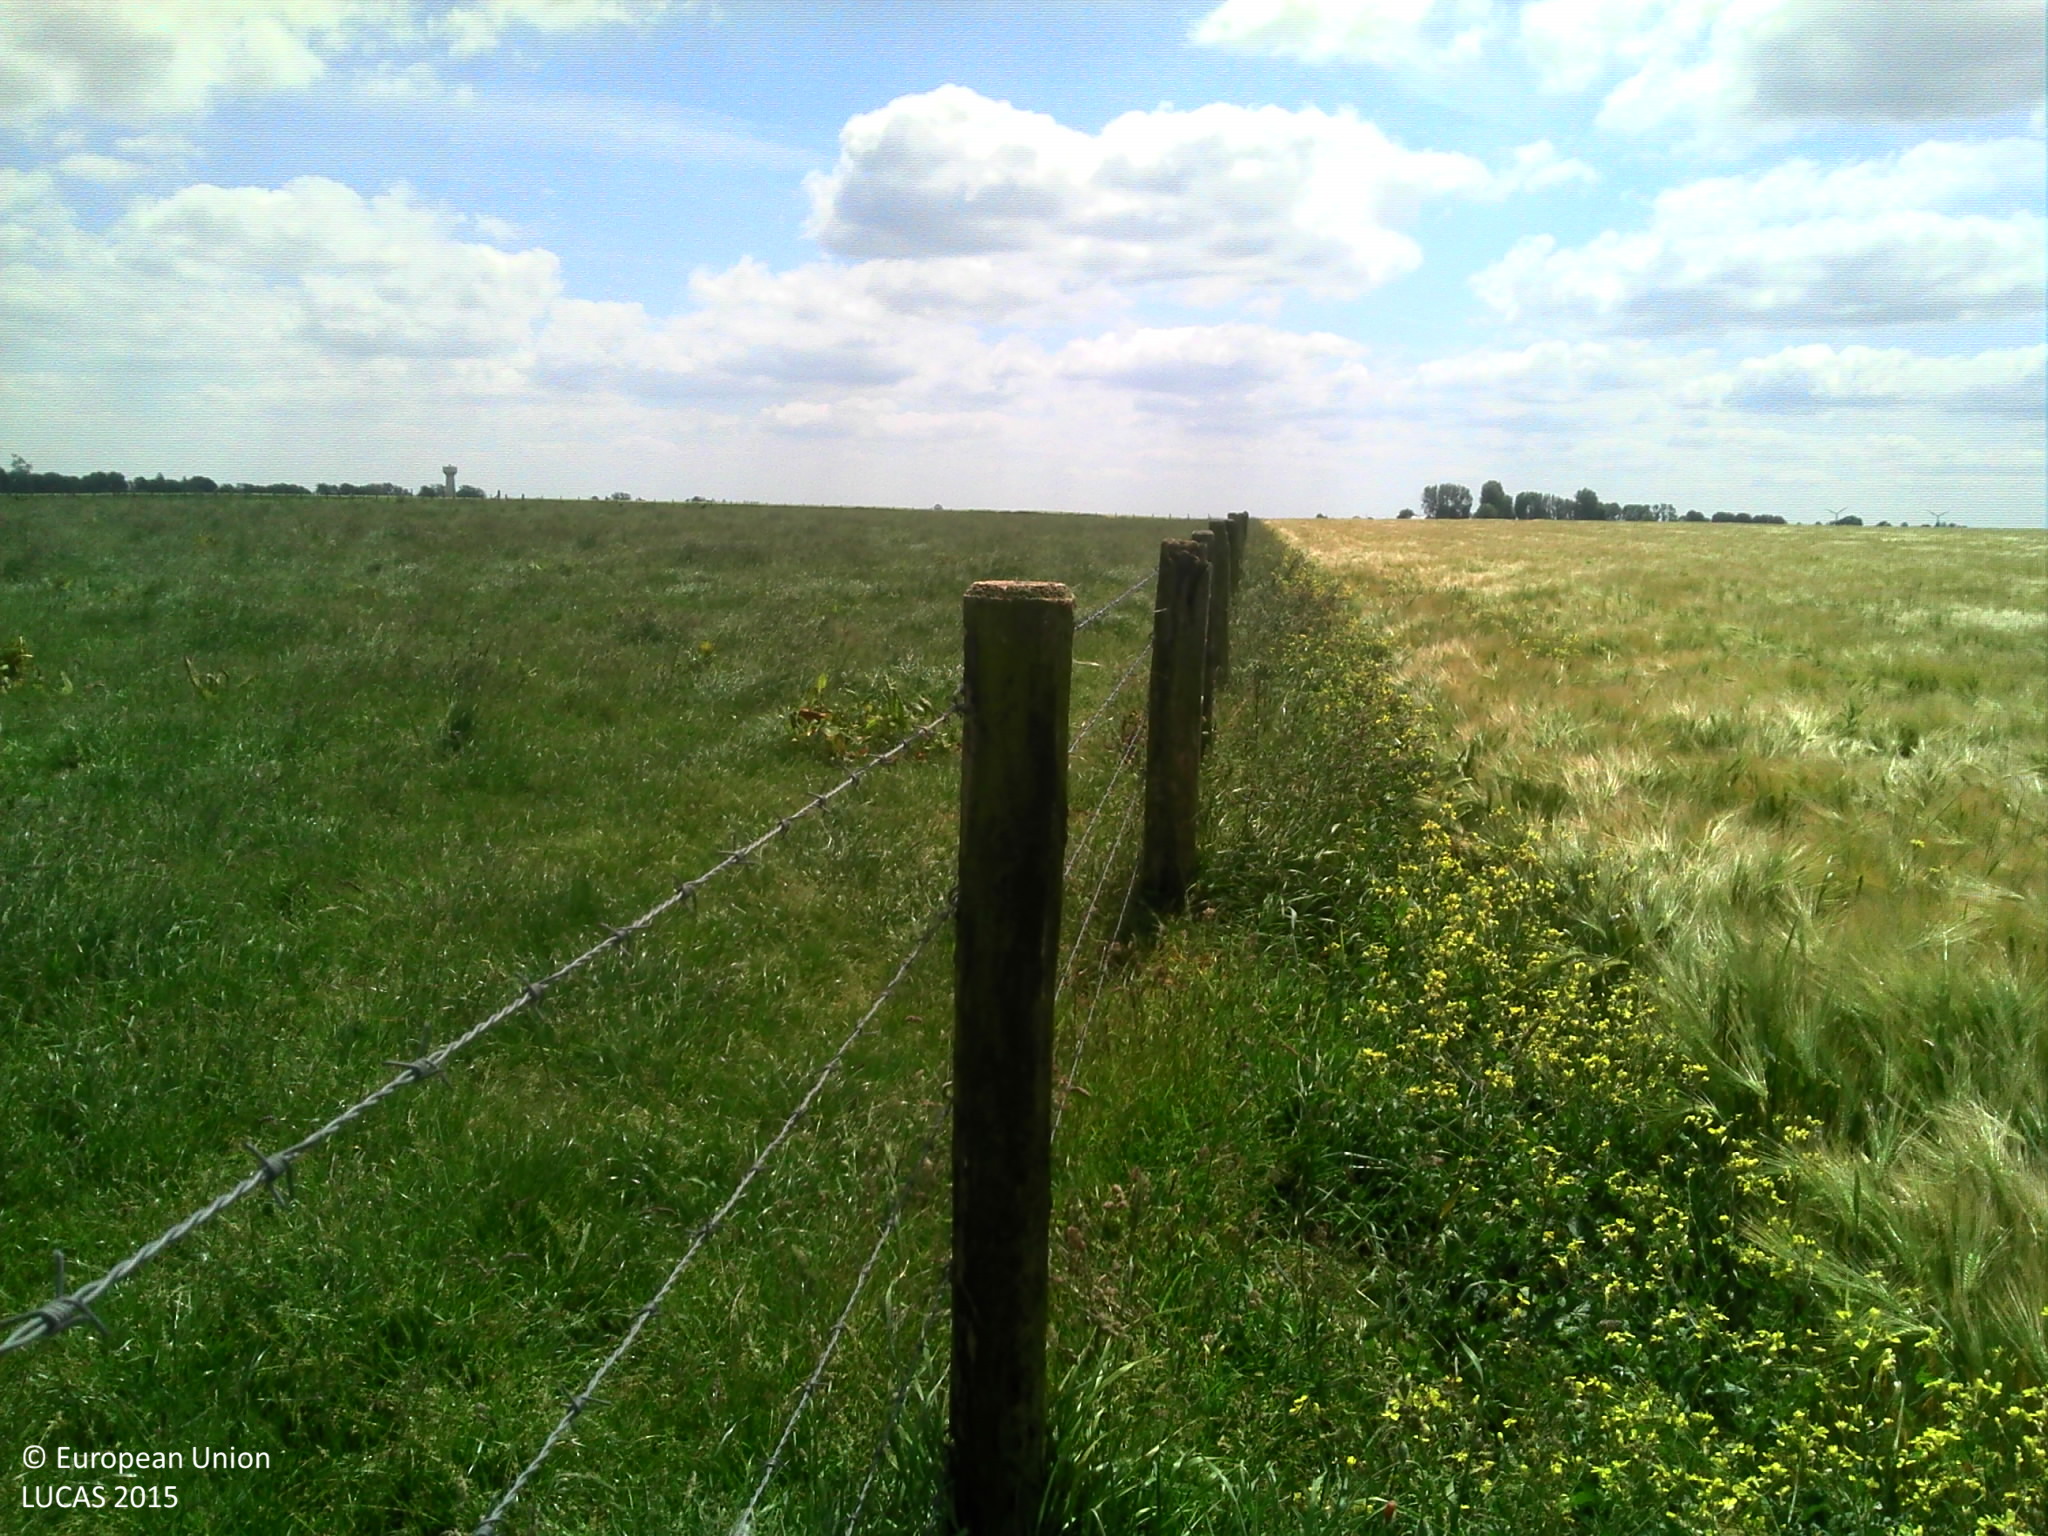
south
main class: Cropland
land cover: Barley
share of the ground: > 75 %
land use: Agriculture (excluding fallow land and kitchen gardens)
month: June
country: FR
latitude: 50.1135
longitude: 1.6616
